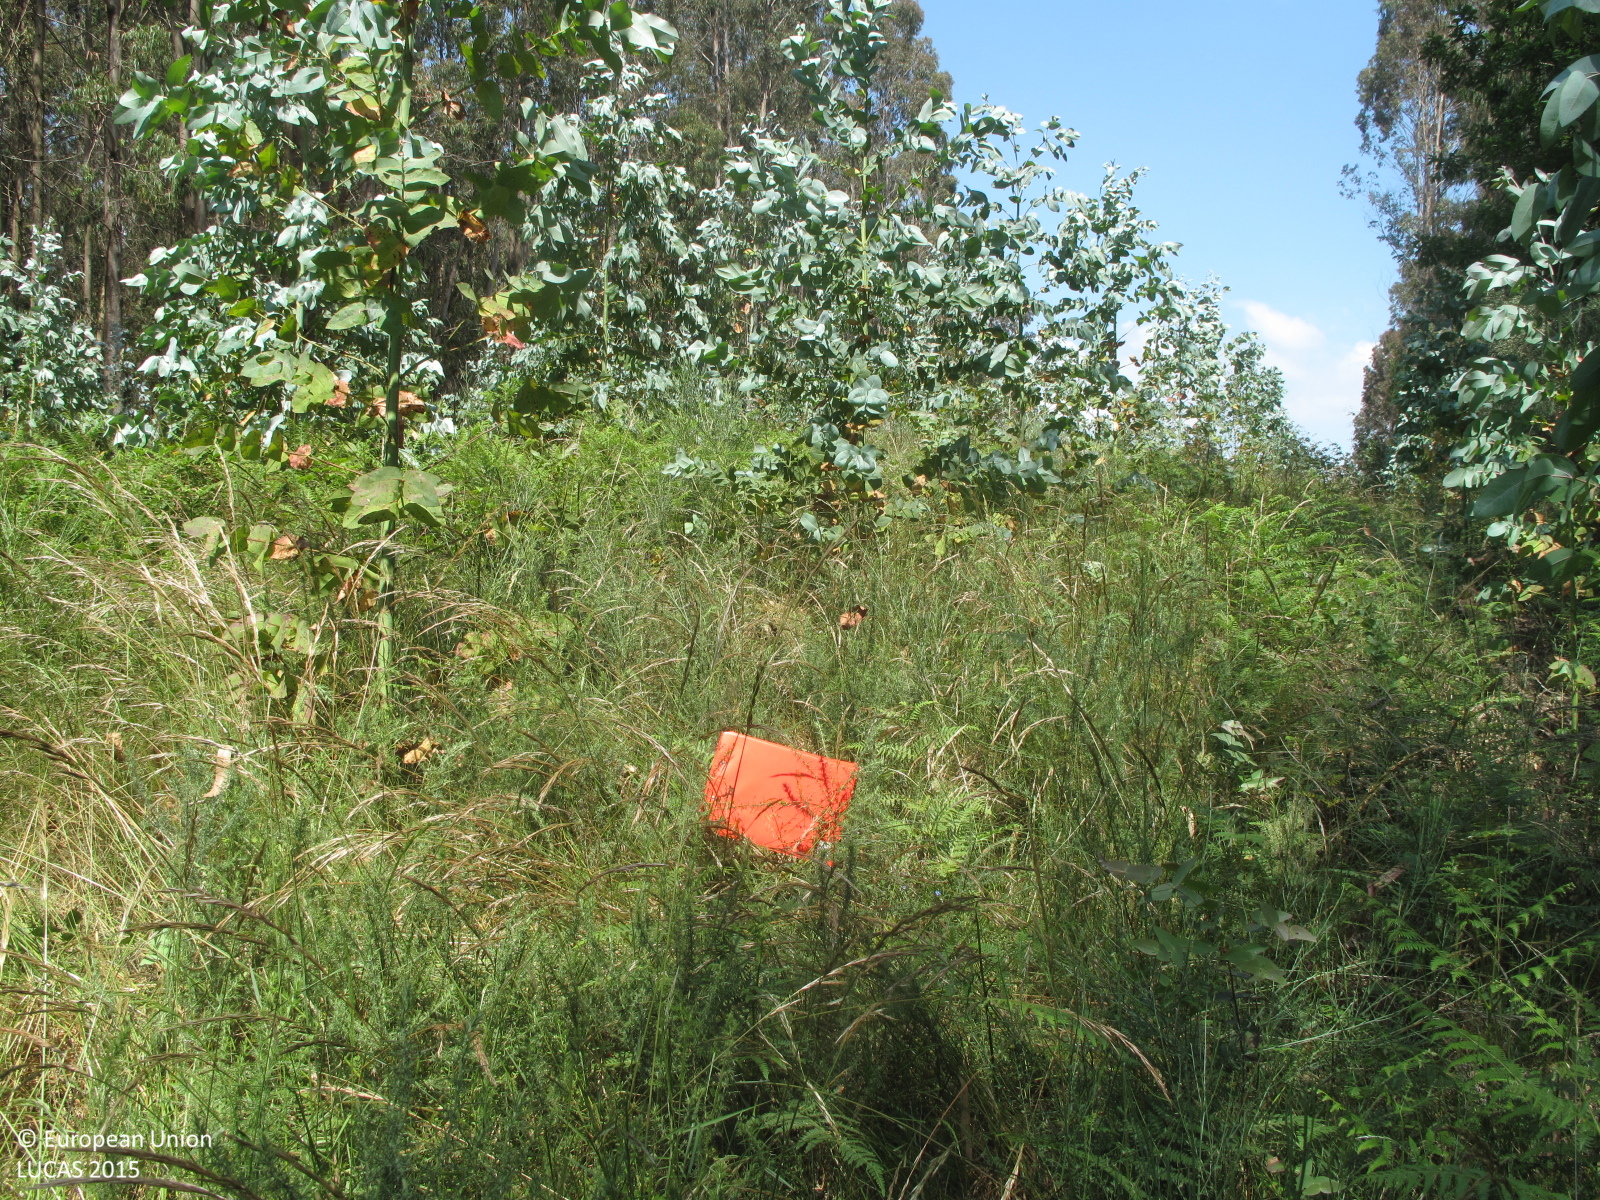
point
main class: Woodland
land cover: Broadleaved woodland
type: exotic forest
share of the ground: 10 - 25 %
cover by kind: shrubs 40 %, herbaceous plants 40 %, broadleaved forest trees 20 %
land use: Forestry
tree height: < 5 m
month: June
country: ES
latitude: 43.0289
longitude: -8.0462
